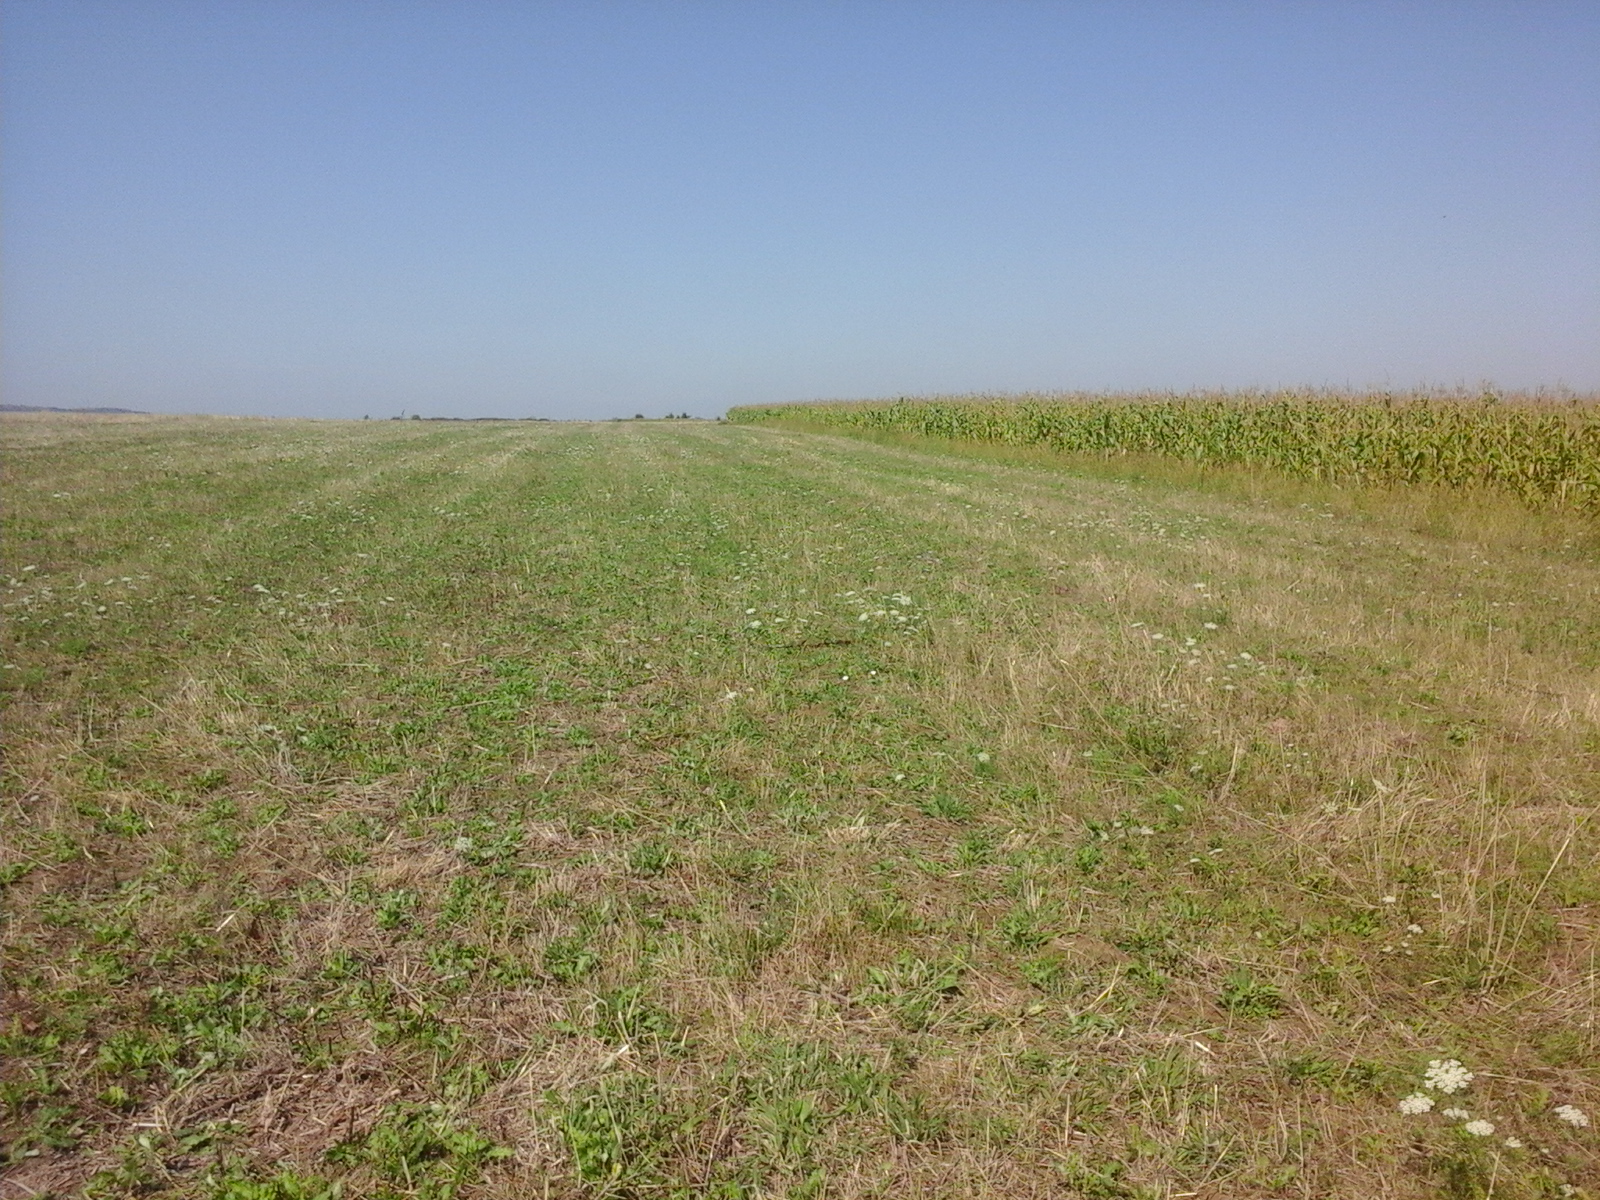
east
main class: Cropland
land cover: Common wheat
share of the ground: 25 - 50 %
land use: Agriculture (excluding fallow land and kitchen gardens)
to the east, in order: Common wheat; Grassland without tree/shrub cover; Tracks; Grassland without tree/shrub cover; Fences; Spontaneously vegetated surfaces
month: August
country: RO
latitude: 45.6109
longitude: 21.7431
